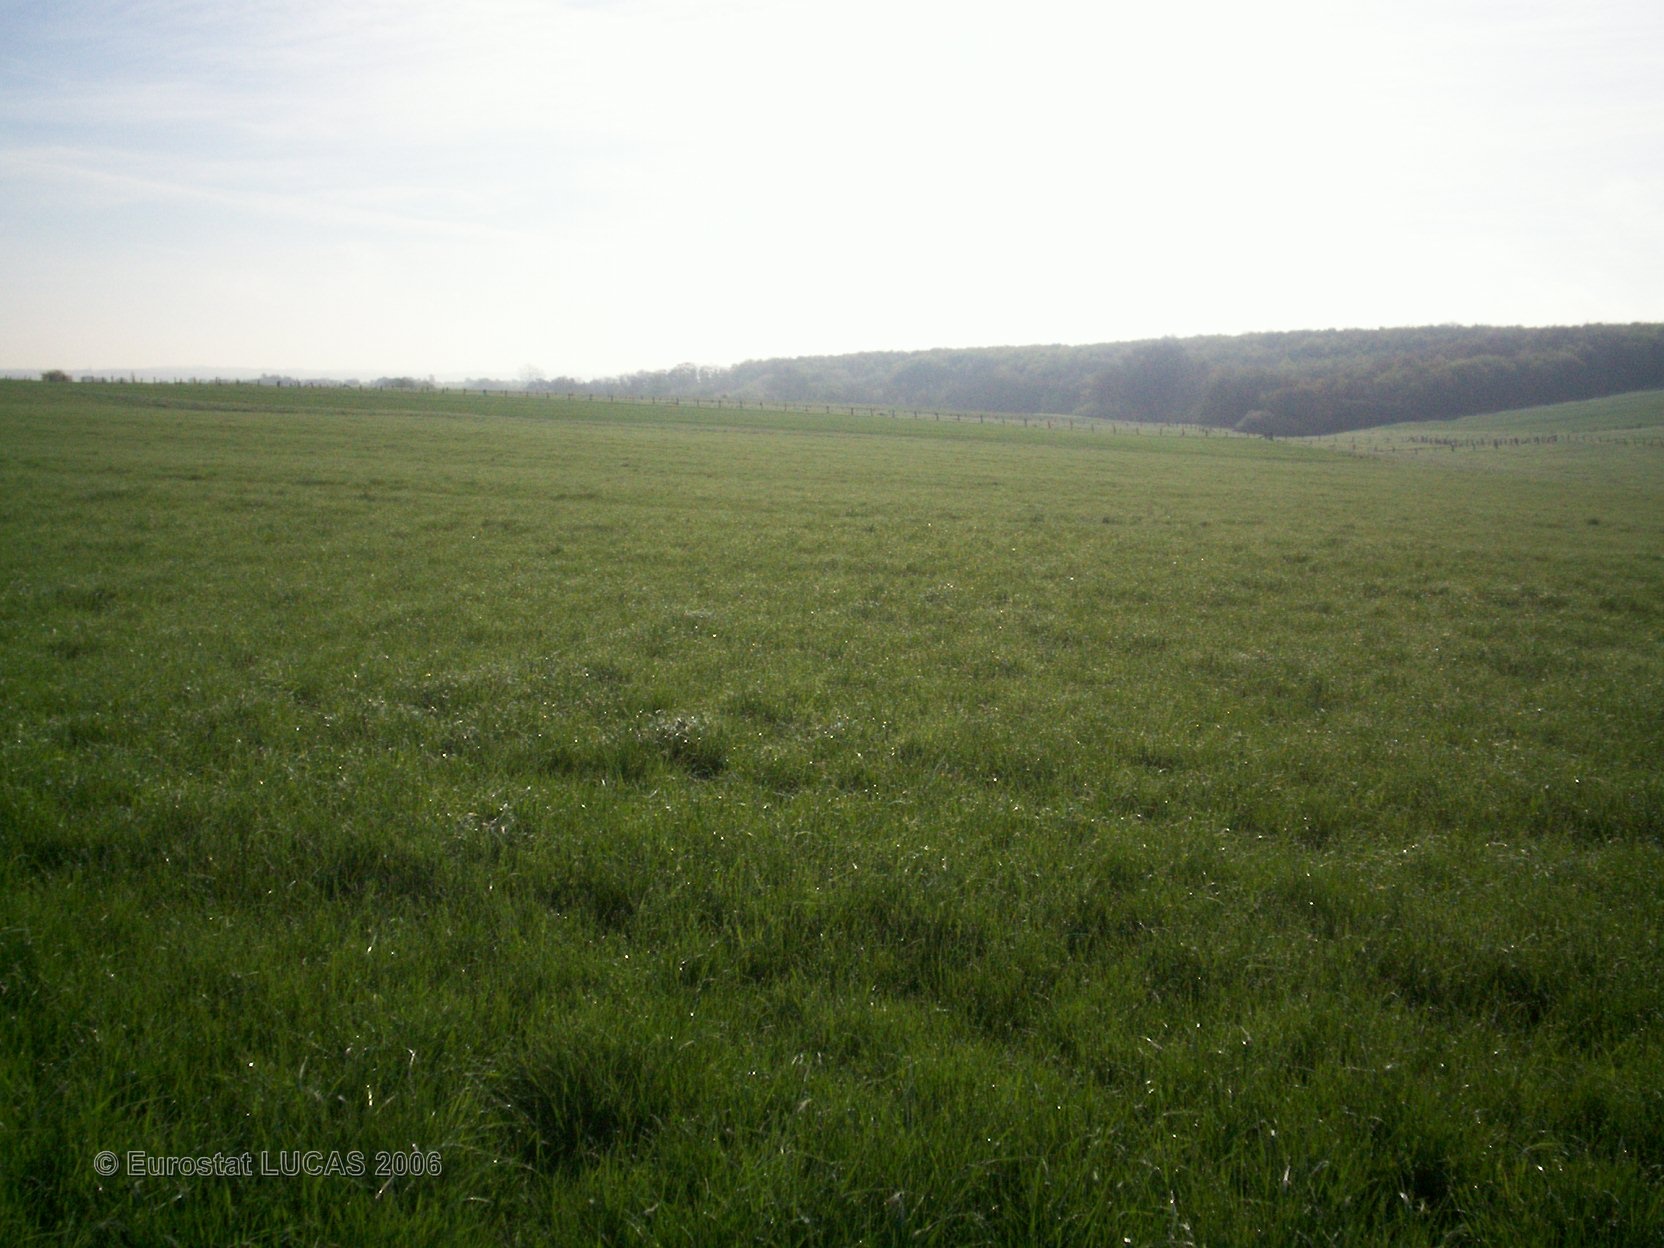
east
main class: Grassland
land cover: Grassland without tree/shrub cover
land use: Agriculture (excluding fallow land and kitchen gardens)
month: May
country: FR
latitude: 49.0987
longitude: 6.9187
